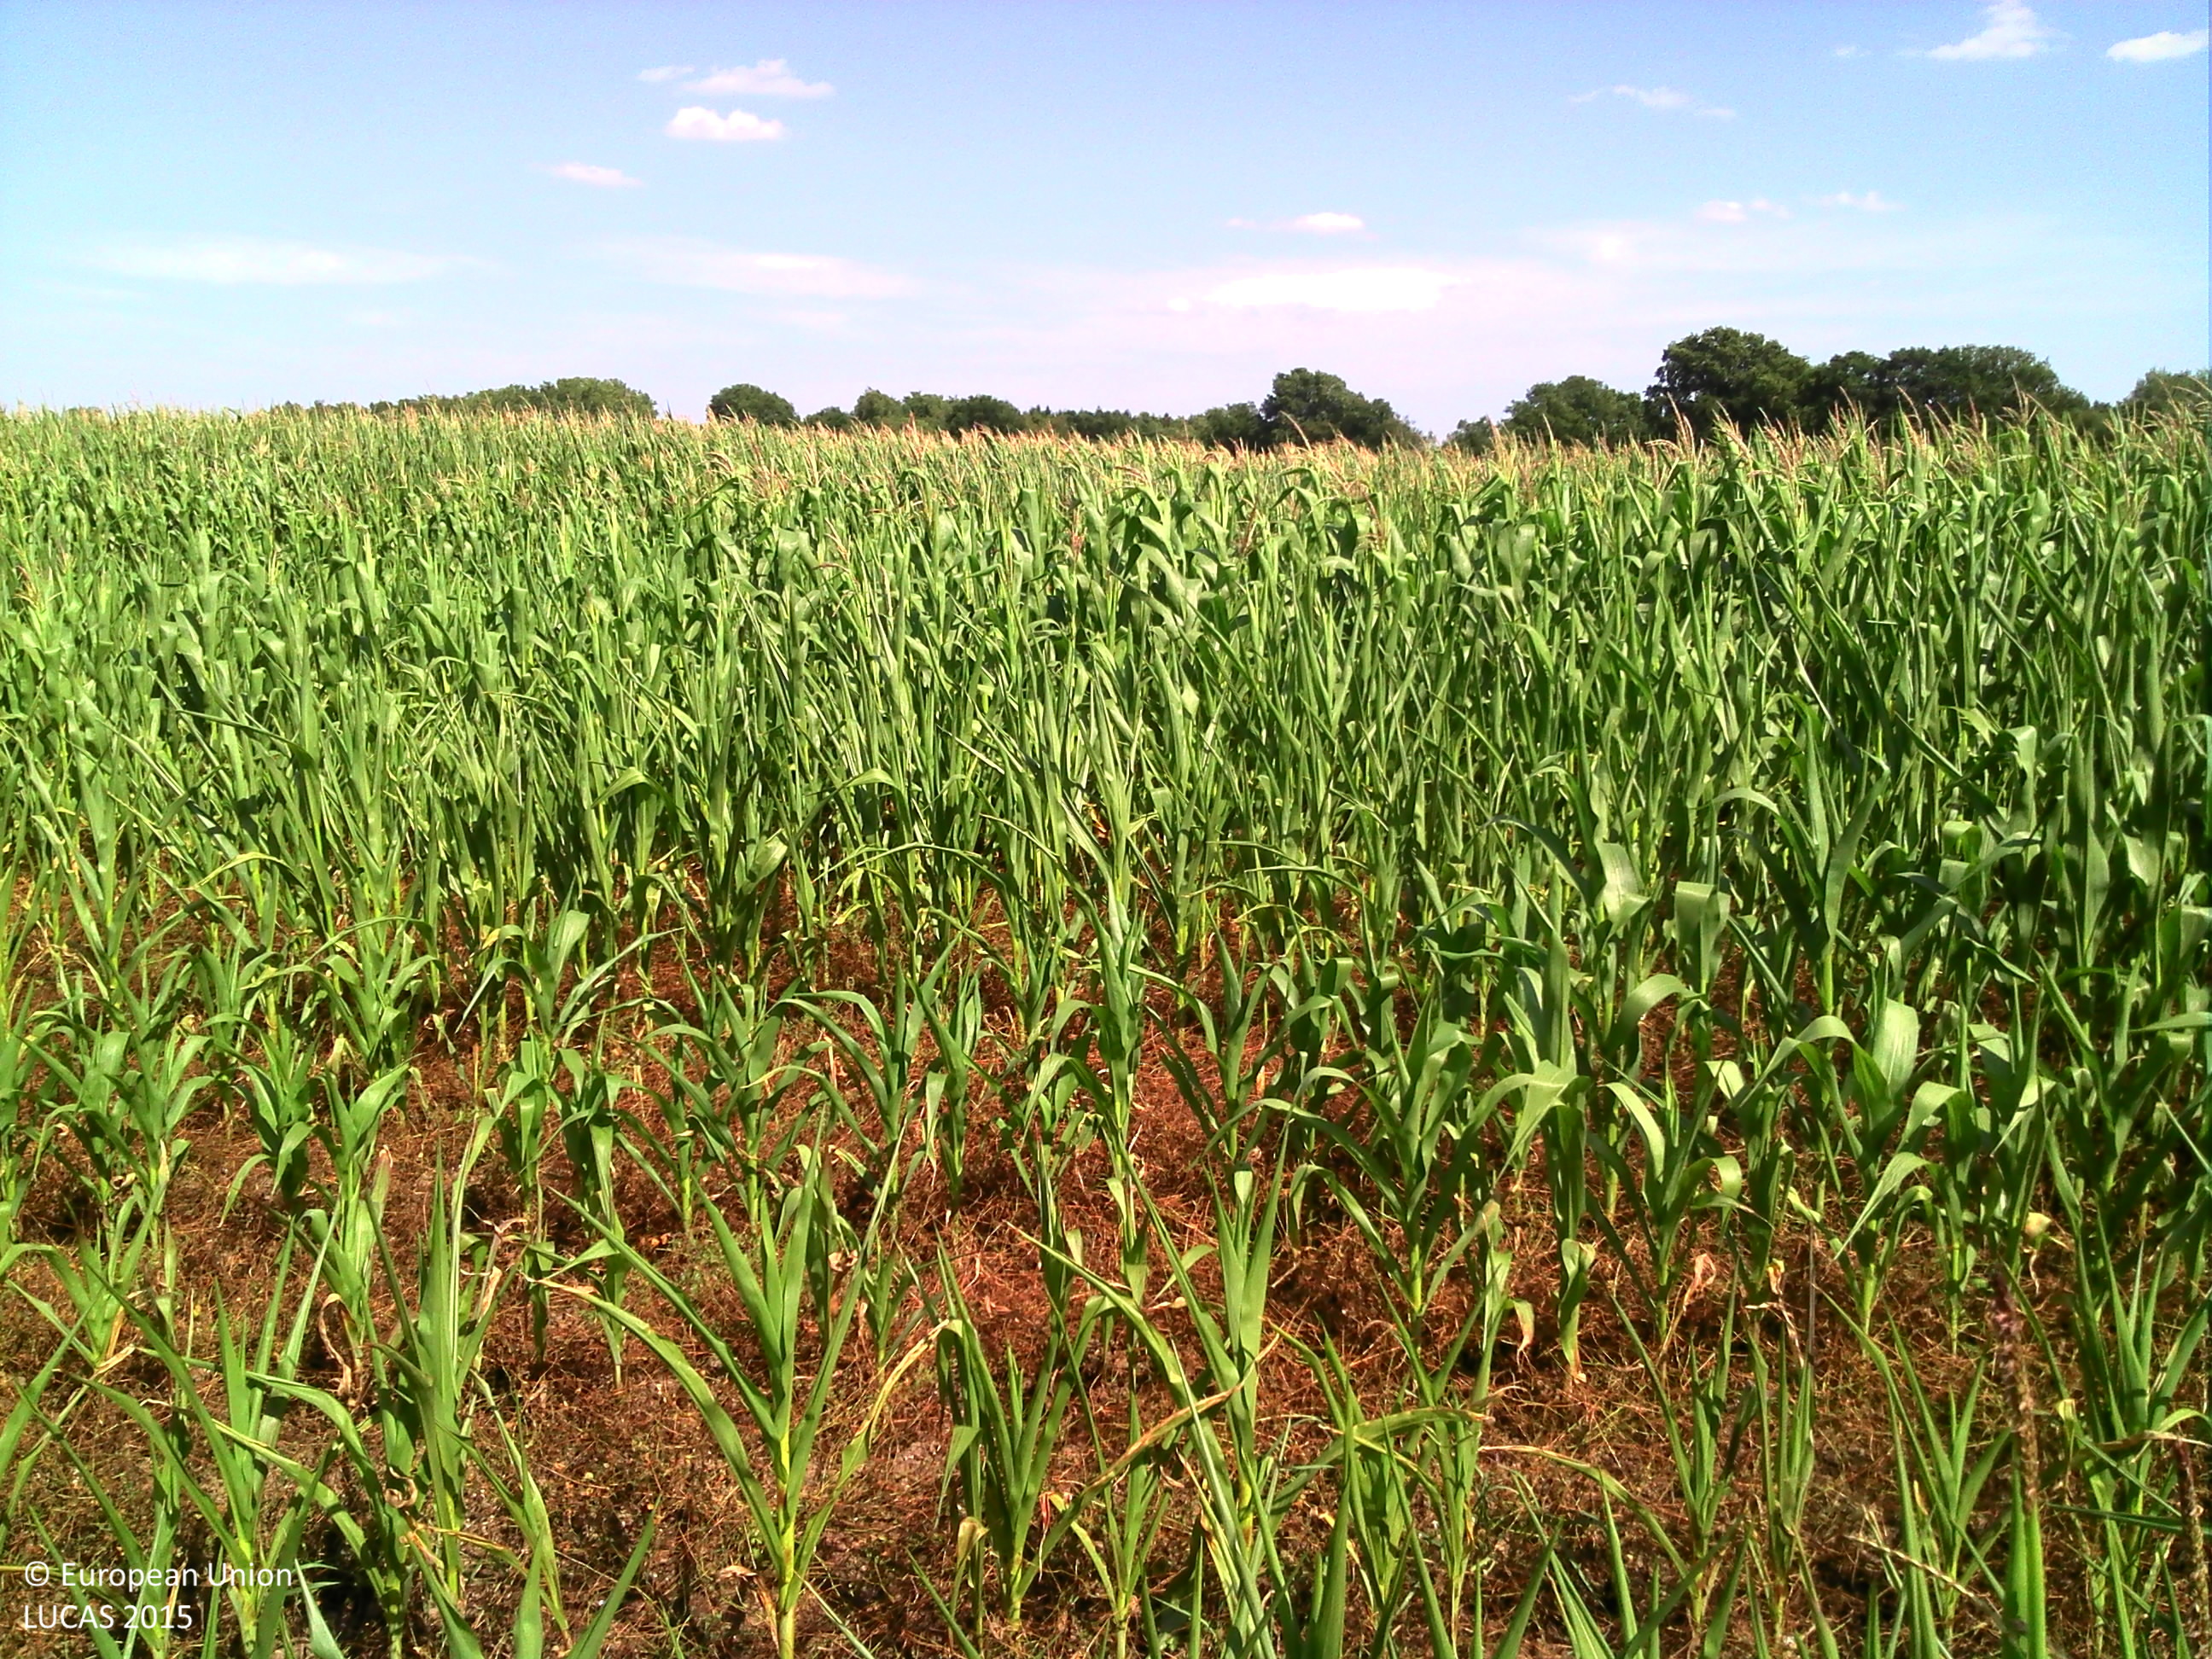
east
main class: Cropland
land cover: Maize
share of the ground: > 75 %
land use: Agriculture (excluding fallow land and kitchen gardens)
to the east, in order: Maize; Grass margins; Fences; Grass margins; Maize; Grass margins; Fences; Grass margins; Maize; Grass margins; Fences; Grassland without tree/shrub cover; Fences; Grass margins; Maize
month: August
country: BE
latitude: 51.1756
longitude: 5.4924
